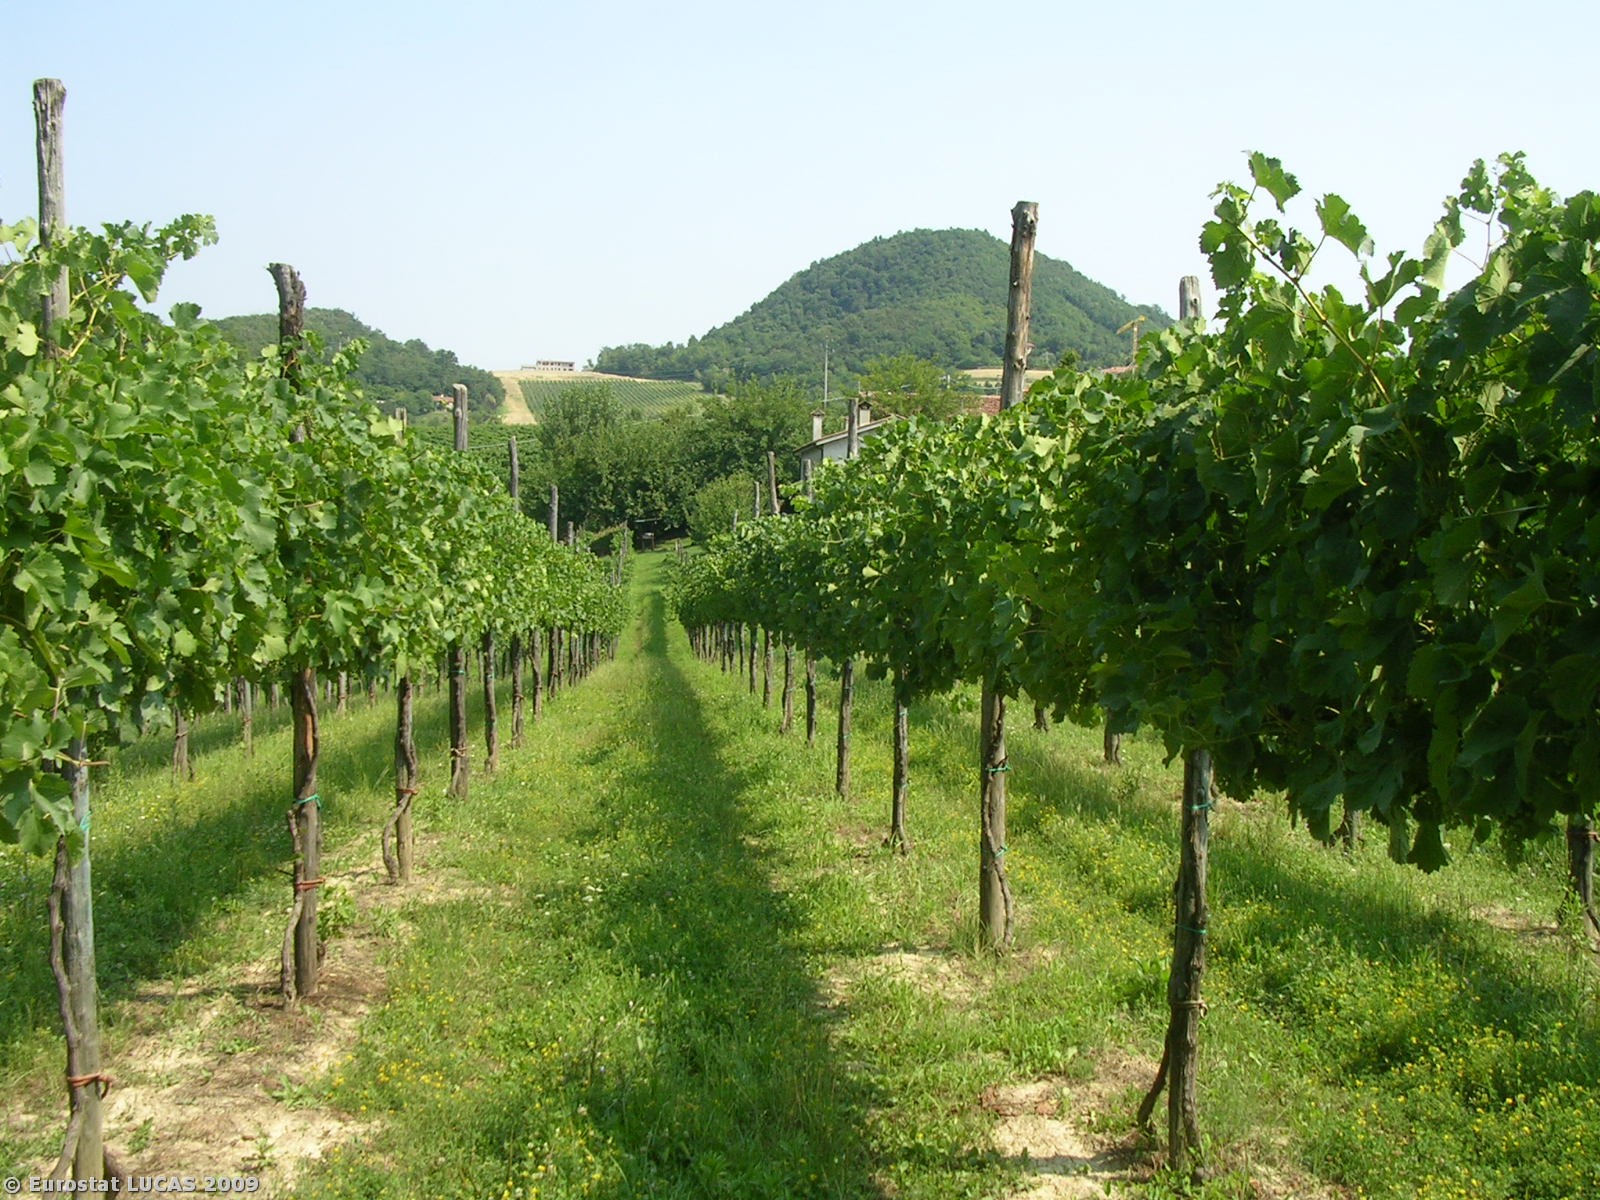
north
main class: Cropland
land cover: Vineyards
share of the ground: > 75 %
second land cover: Grassland with sparse tree/shrub cover
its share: 10 - 25 %
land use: Agriculture (excluding fallow land and kitchen gardens)
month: July
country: IT
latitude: 45.3462
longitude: 11.7201
